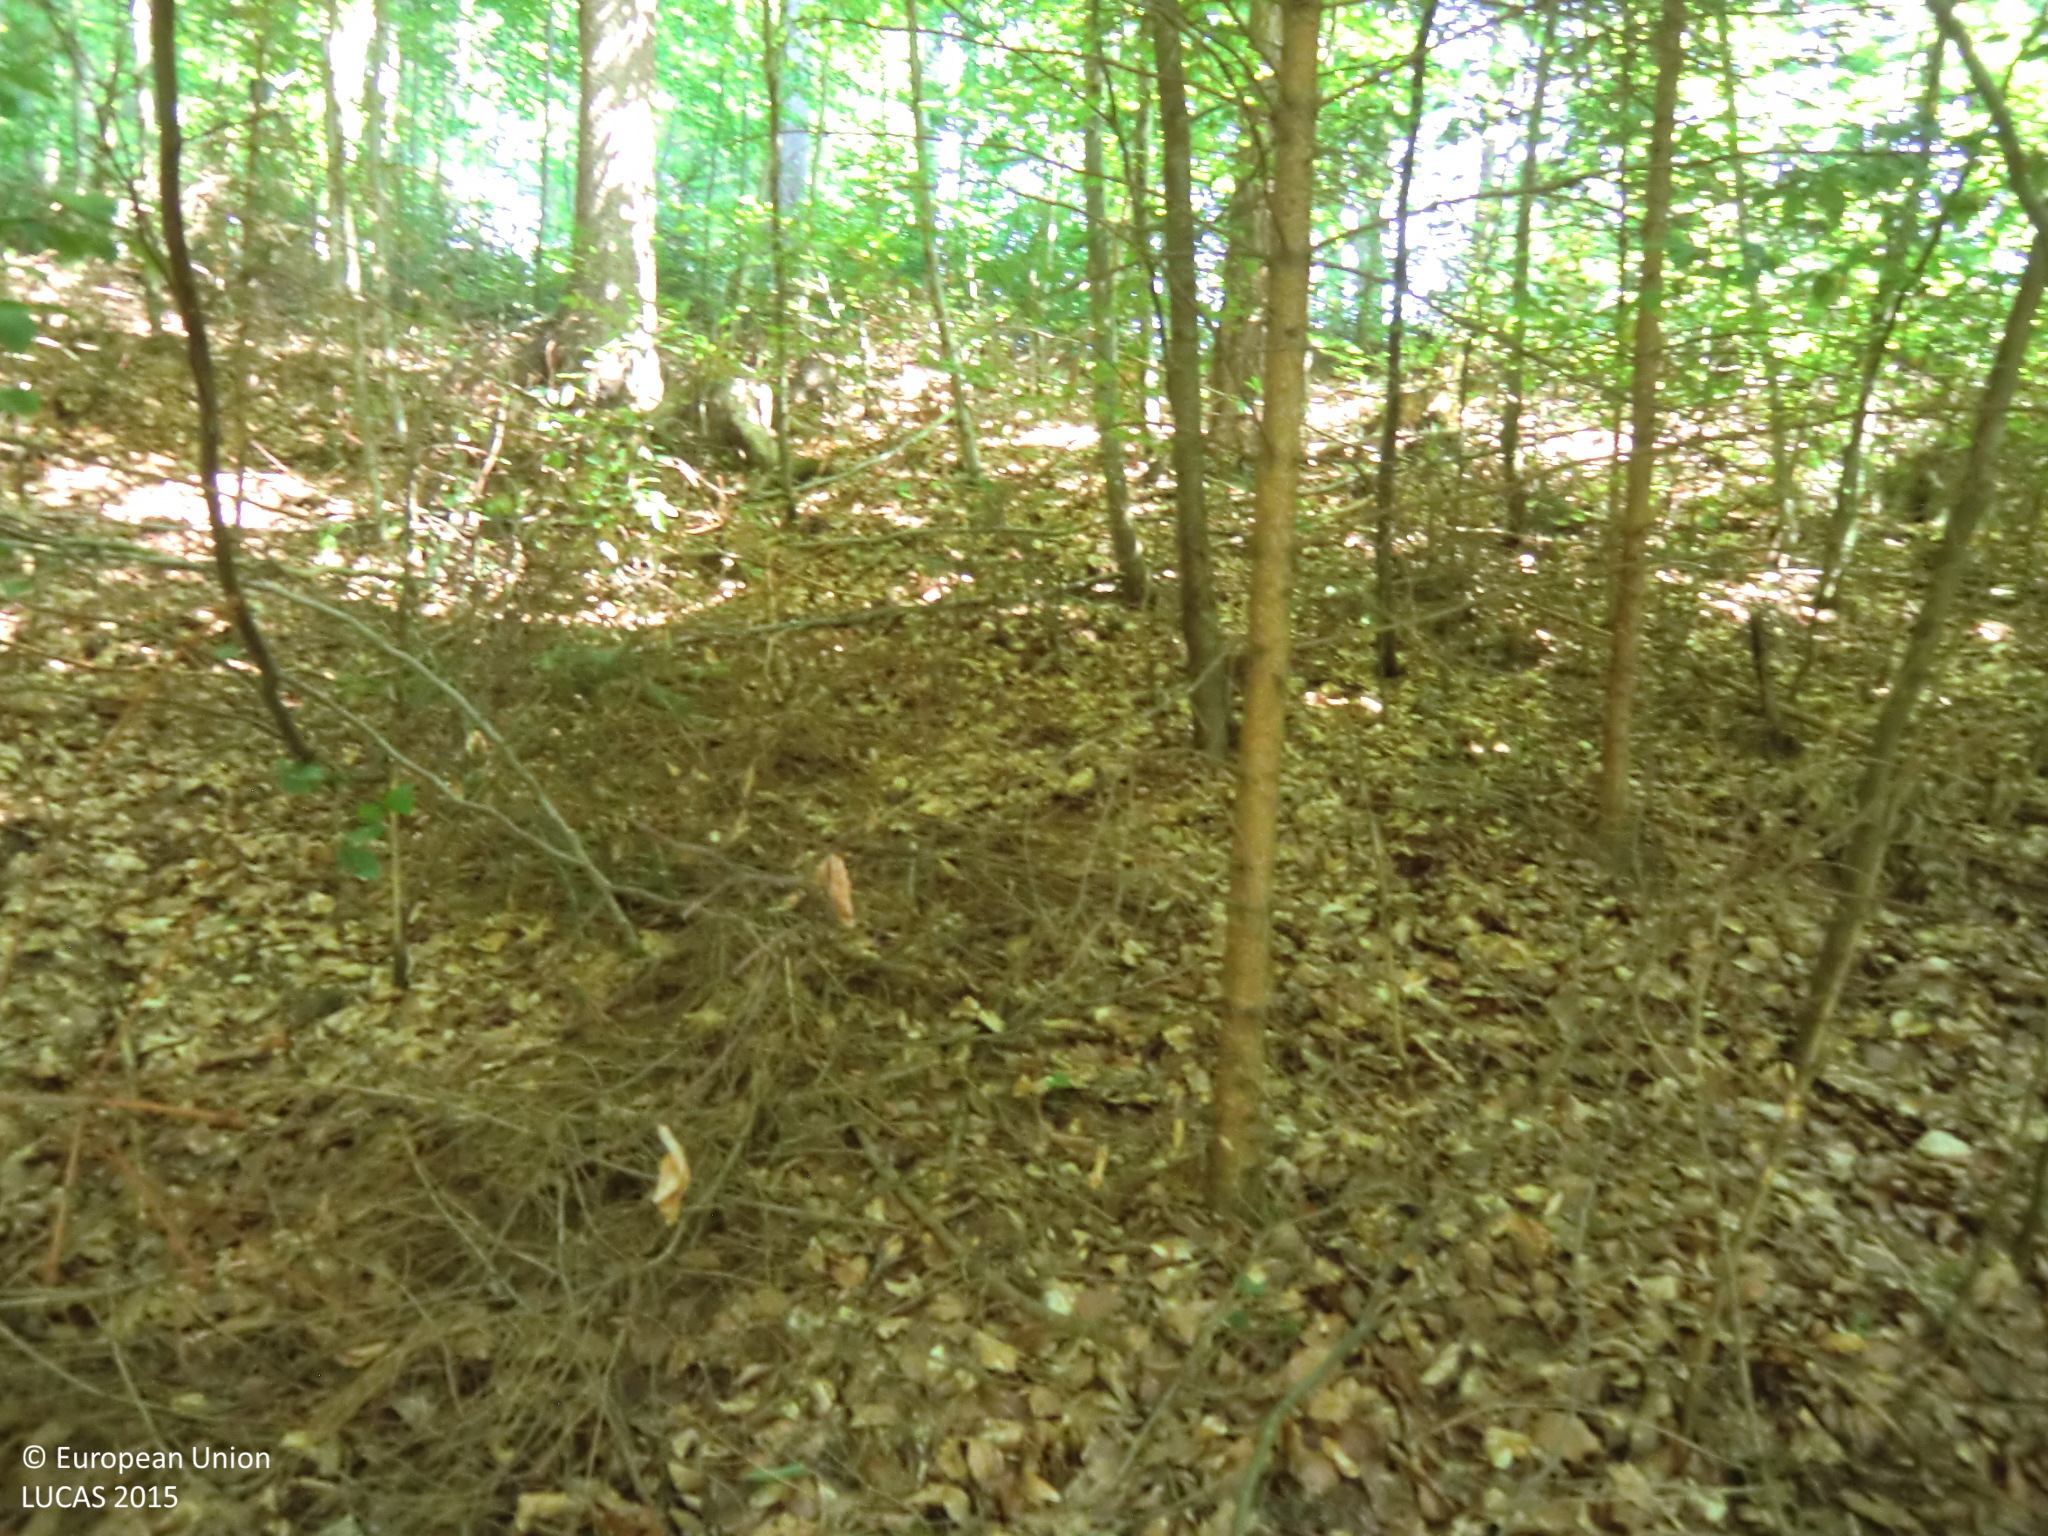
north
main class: Woodland
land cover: Spruce dominated mixed woodland
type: hemiboreal forest and nemoral coniferous forest and mixed broadleaved-coniferous forest
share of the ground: > 75 %
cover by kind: coniferous forest trees 45 %, broadleaved forest trees 45 %, unconsolidated bare surface 10 %
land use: Forestry
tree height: > 5 m
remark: Harvested field
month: July
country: AT
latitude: 47.1360
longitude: 15.7360
